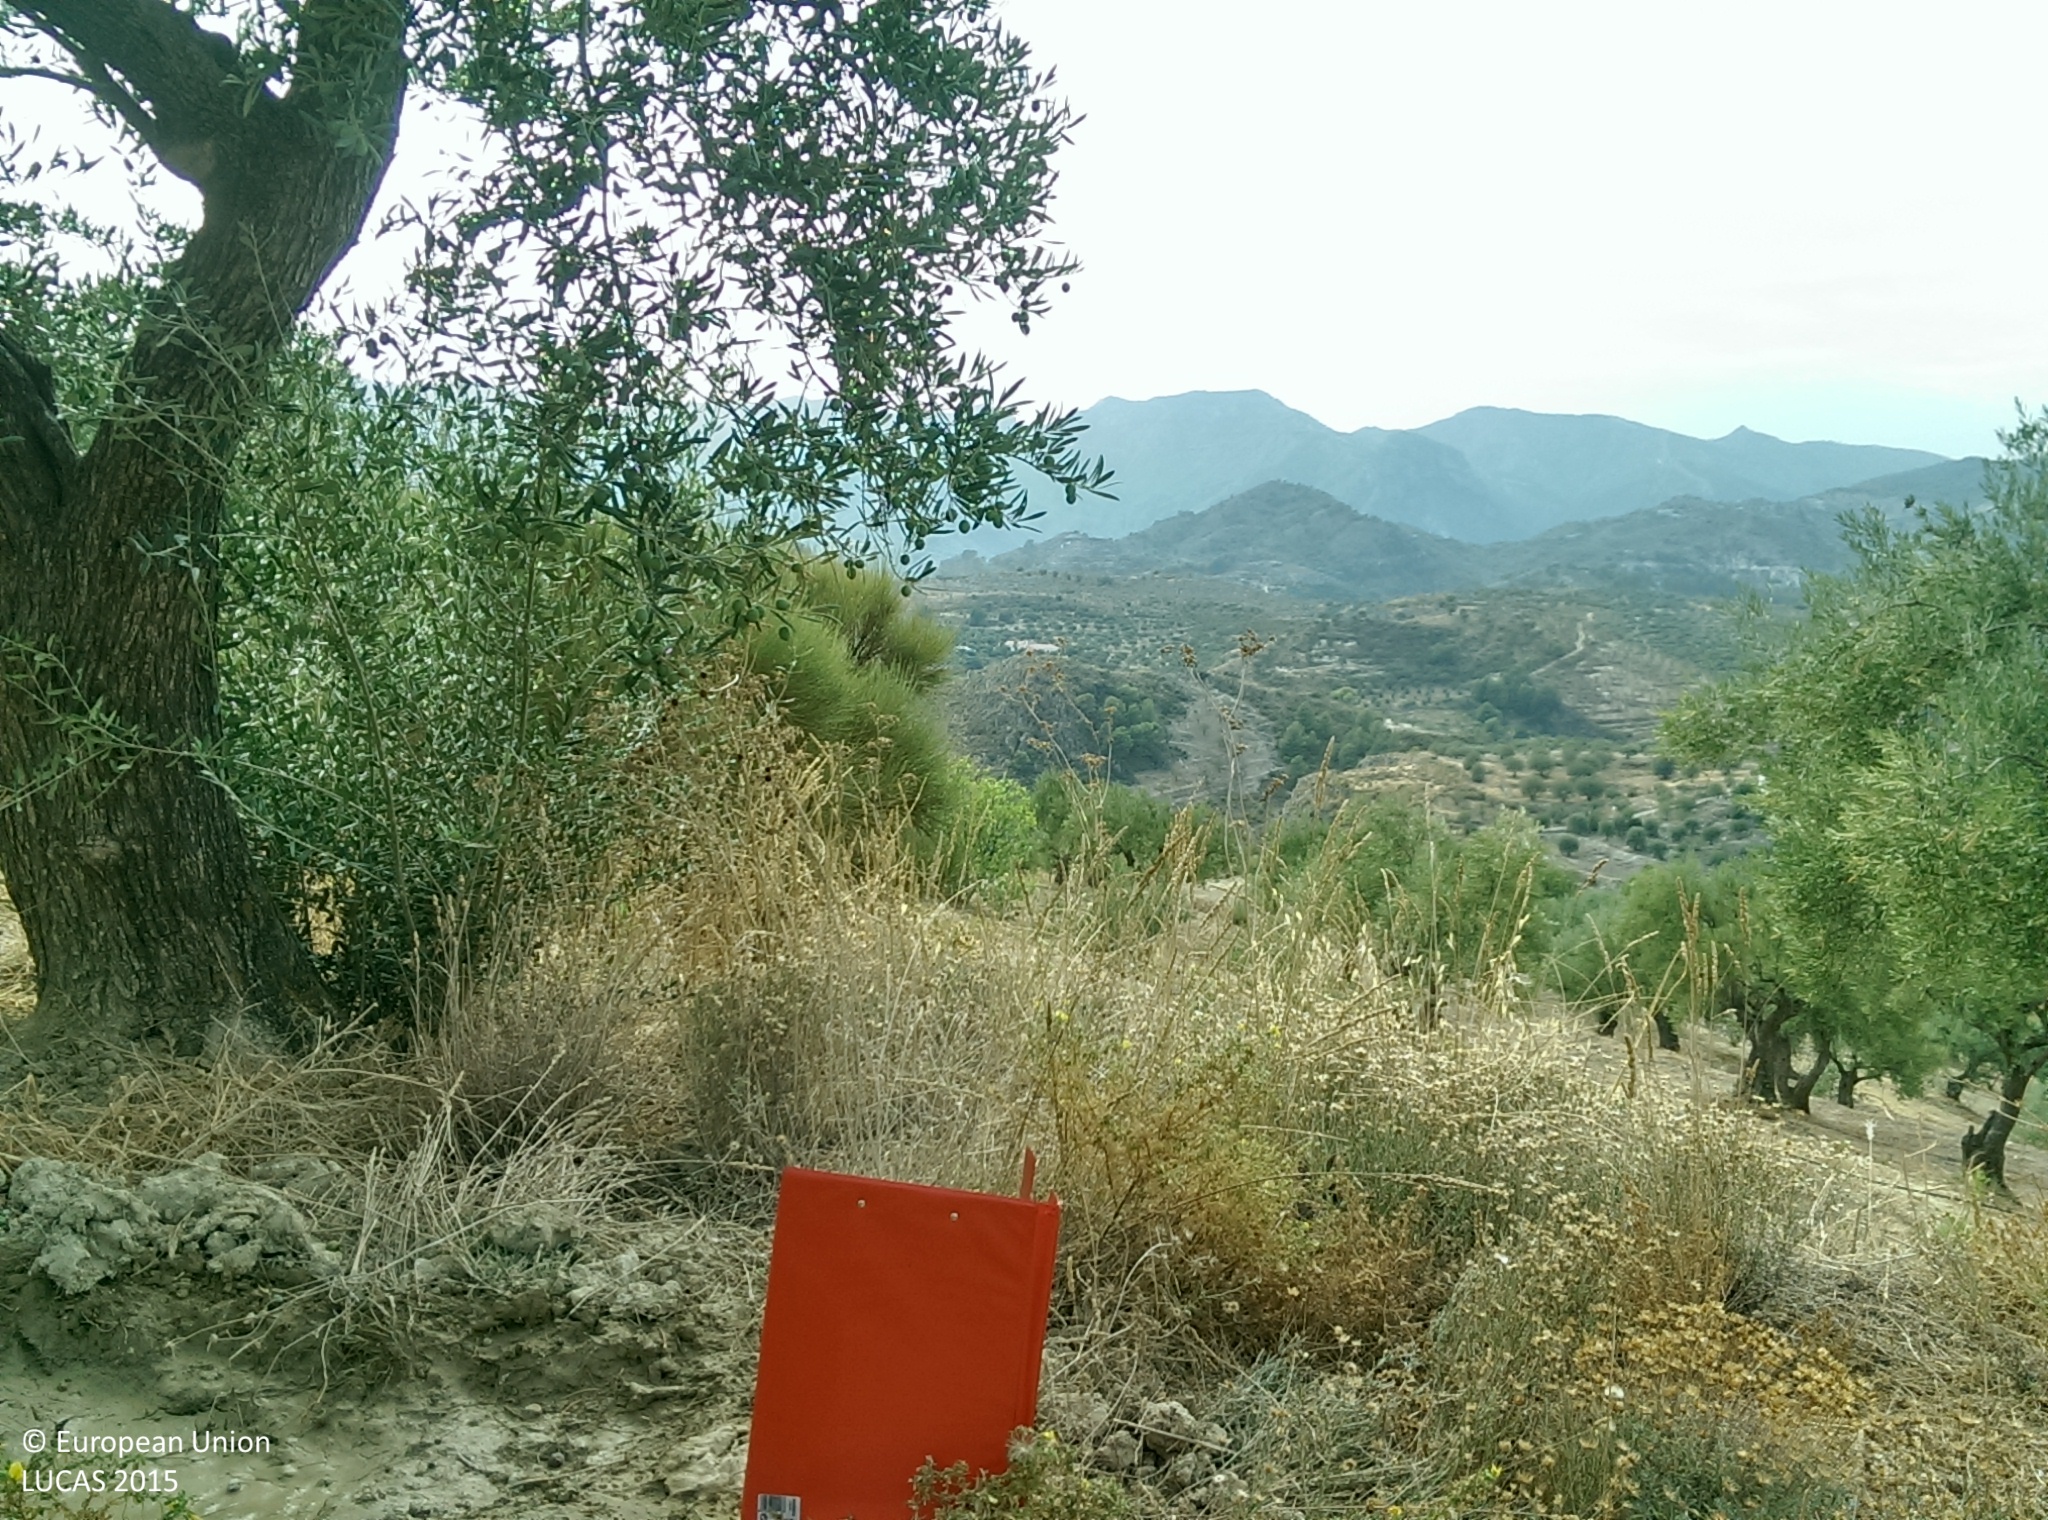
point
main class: Cropland
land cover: Olive groves
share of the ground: 50 - 75 %
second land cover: Spontaneously vegetated surfaces
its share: 50 - 75 %
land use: Agriculture (excluding fallow land and kitchen gardens)
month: August
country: ES
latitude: 36.8589
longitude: -3.5893
